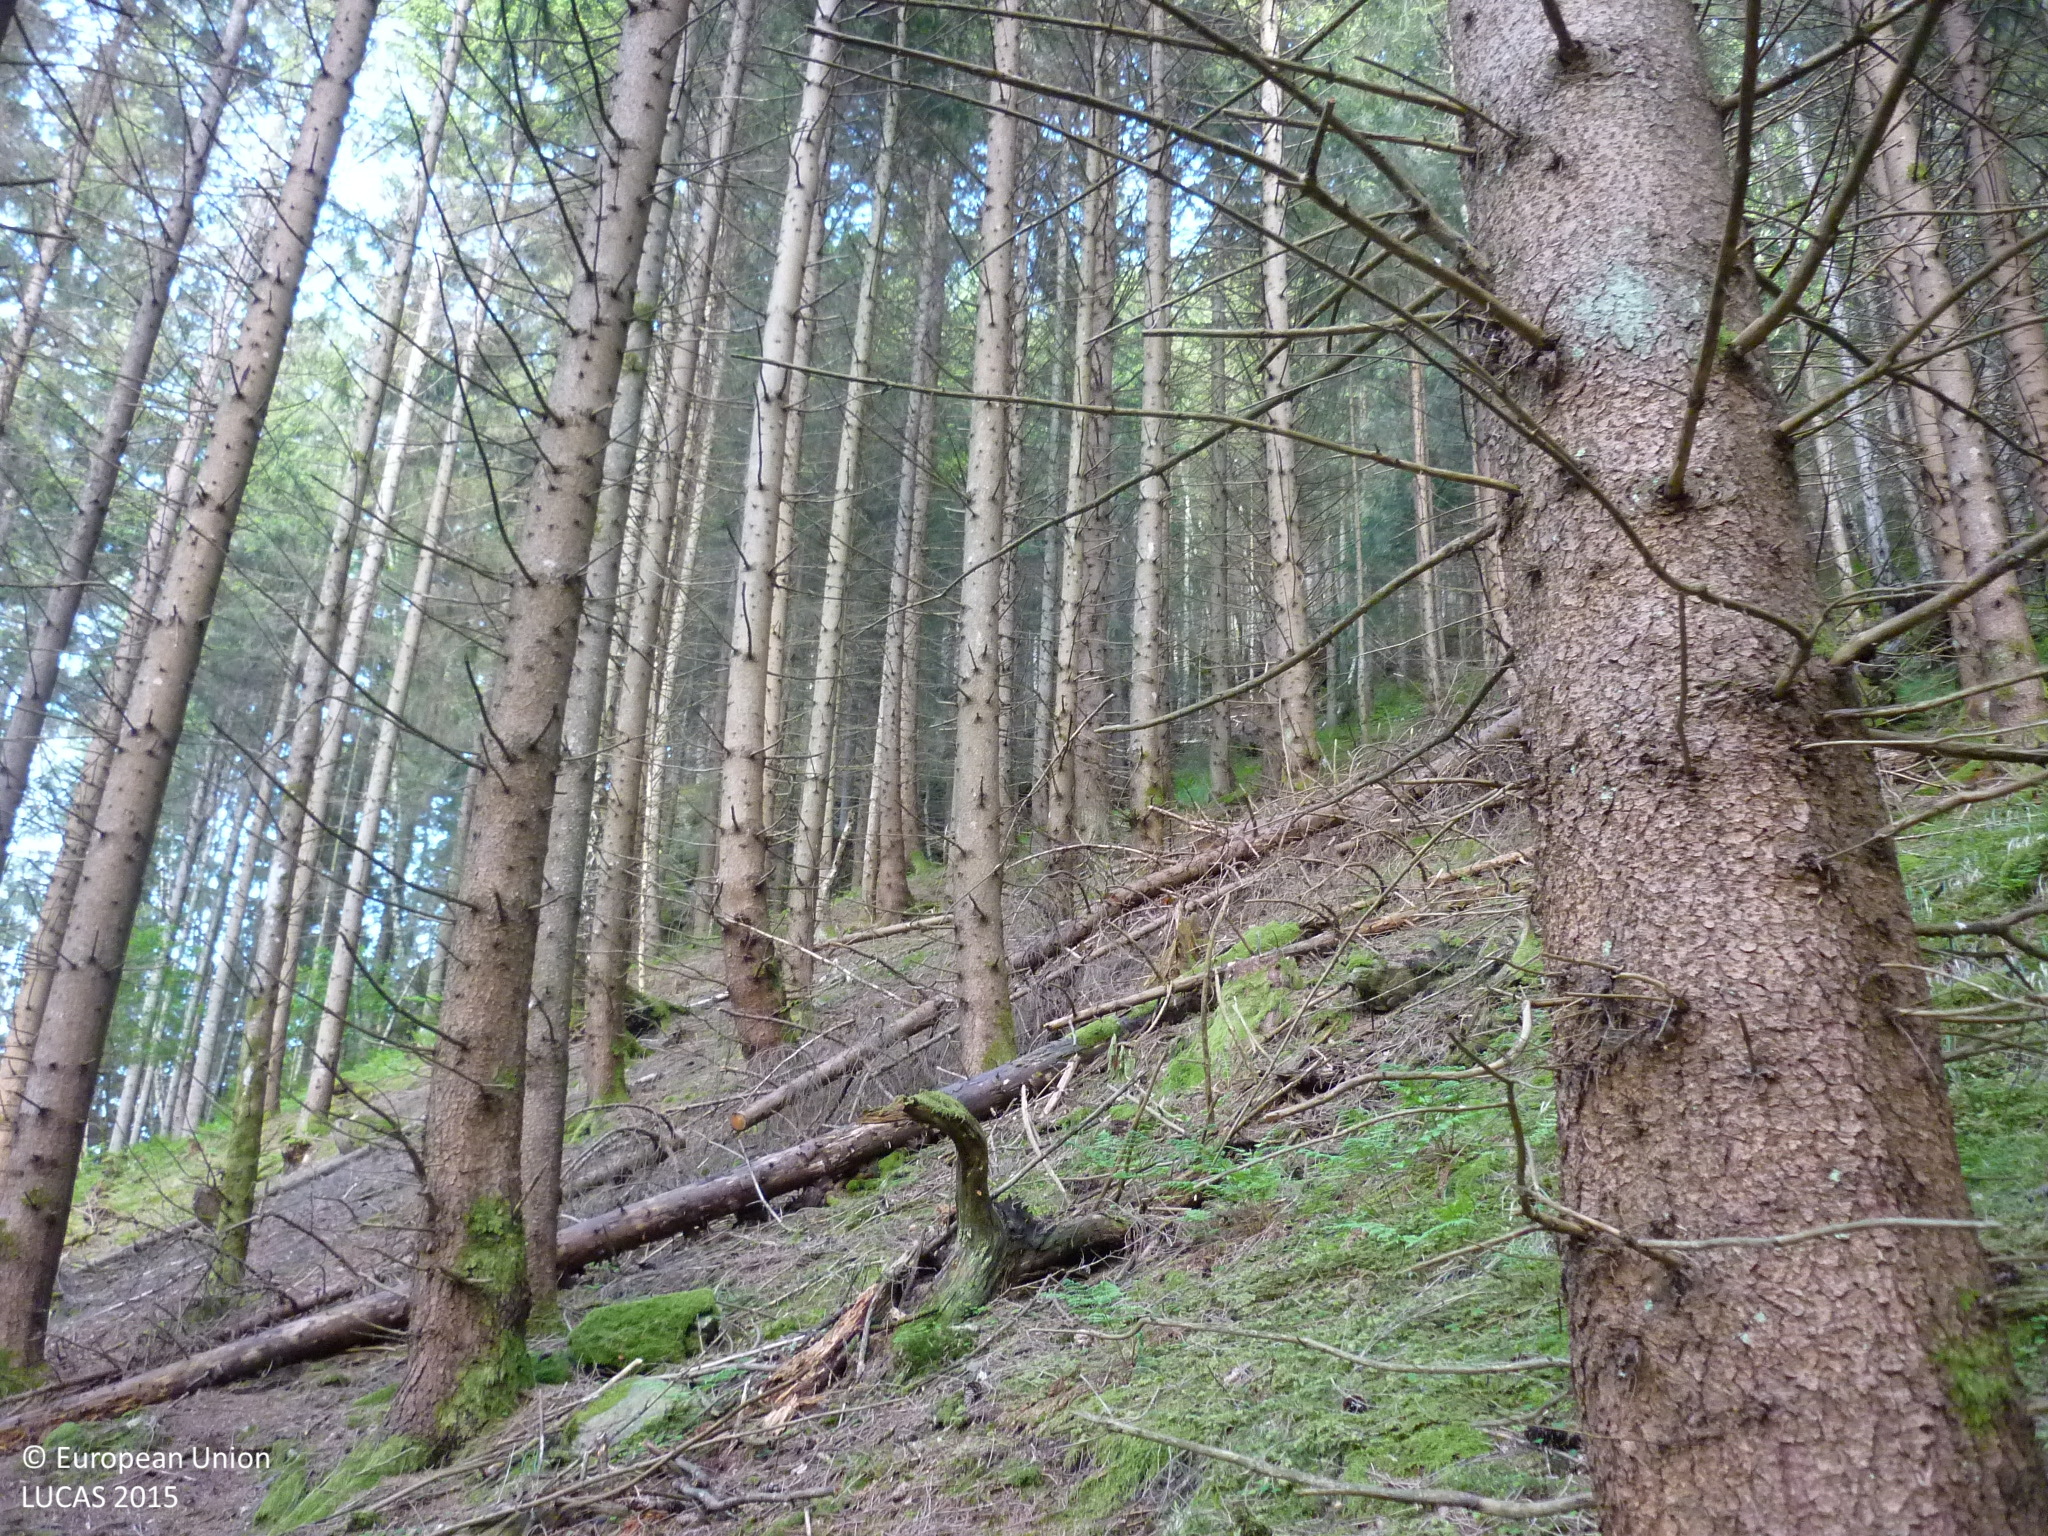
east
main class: Woodland
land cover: Spruce dominated coniferous woodland
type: alpine coniferous forest
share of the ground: > 75 %
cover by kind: coniferous forest trees 90 %, herbaceous plants 5 %, lichens and mosses 5 %
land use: Forestry
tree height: > 5 m
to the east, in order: Spruce dominated coniferous woodland; Grassland with sparse tree/shrub cover; Spruce dominated mixed woodland
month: May
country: AT
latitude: 47.1052
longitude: 14.0170
